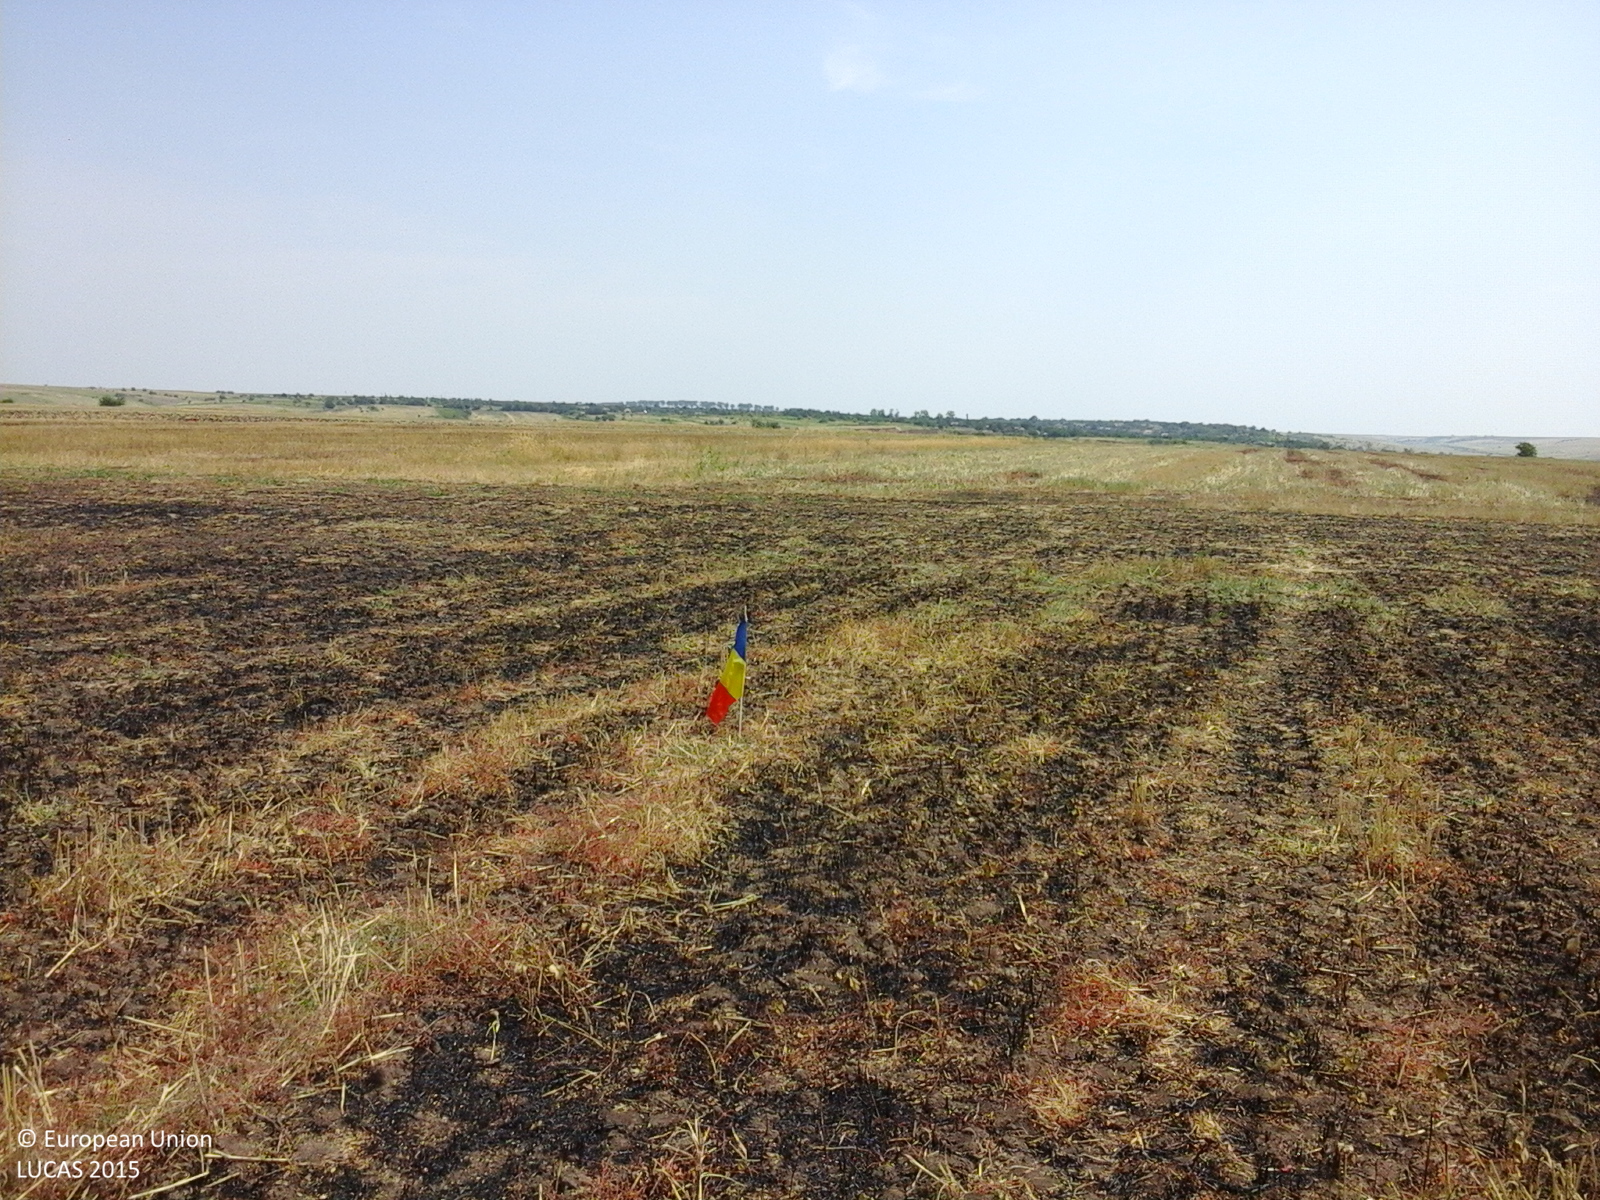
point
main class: Cropland
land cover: Common wheat
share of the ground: 25 - 50 %
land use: Agriculture (excluding fallow land and kitchen gardens)
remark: Burnt area
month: August
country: RO
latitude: 44.1941
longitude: 23.2212
